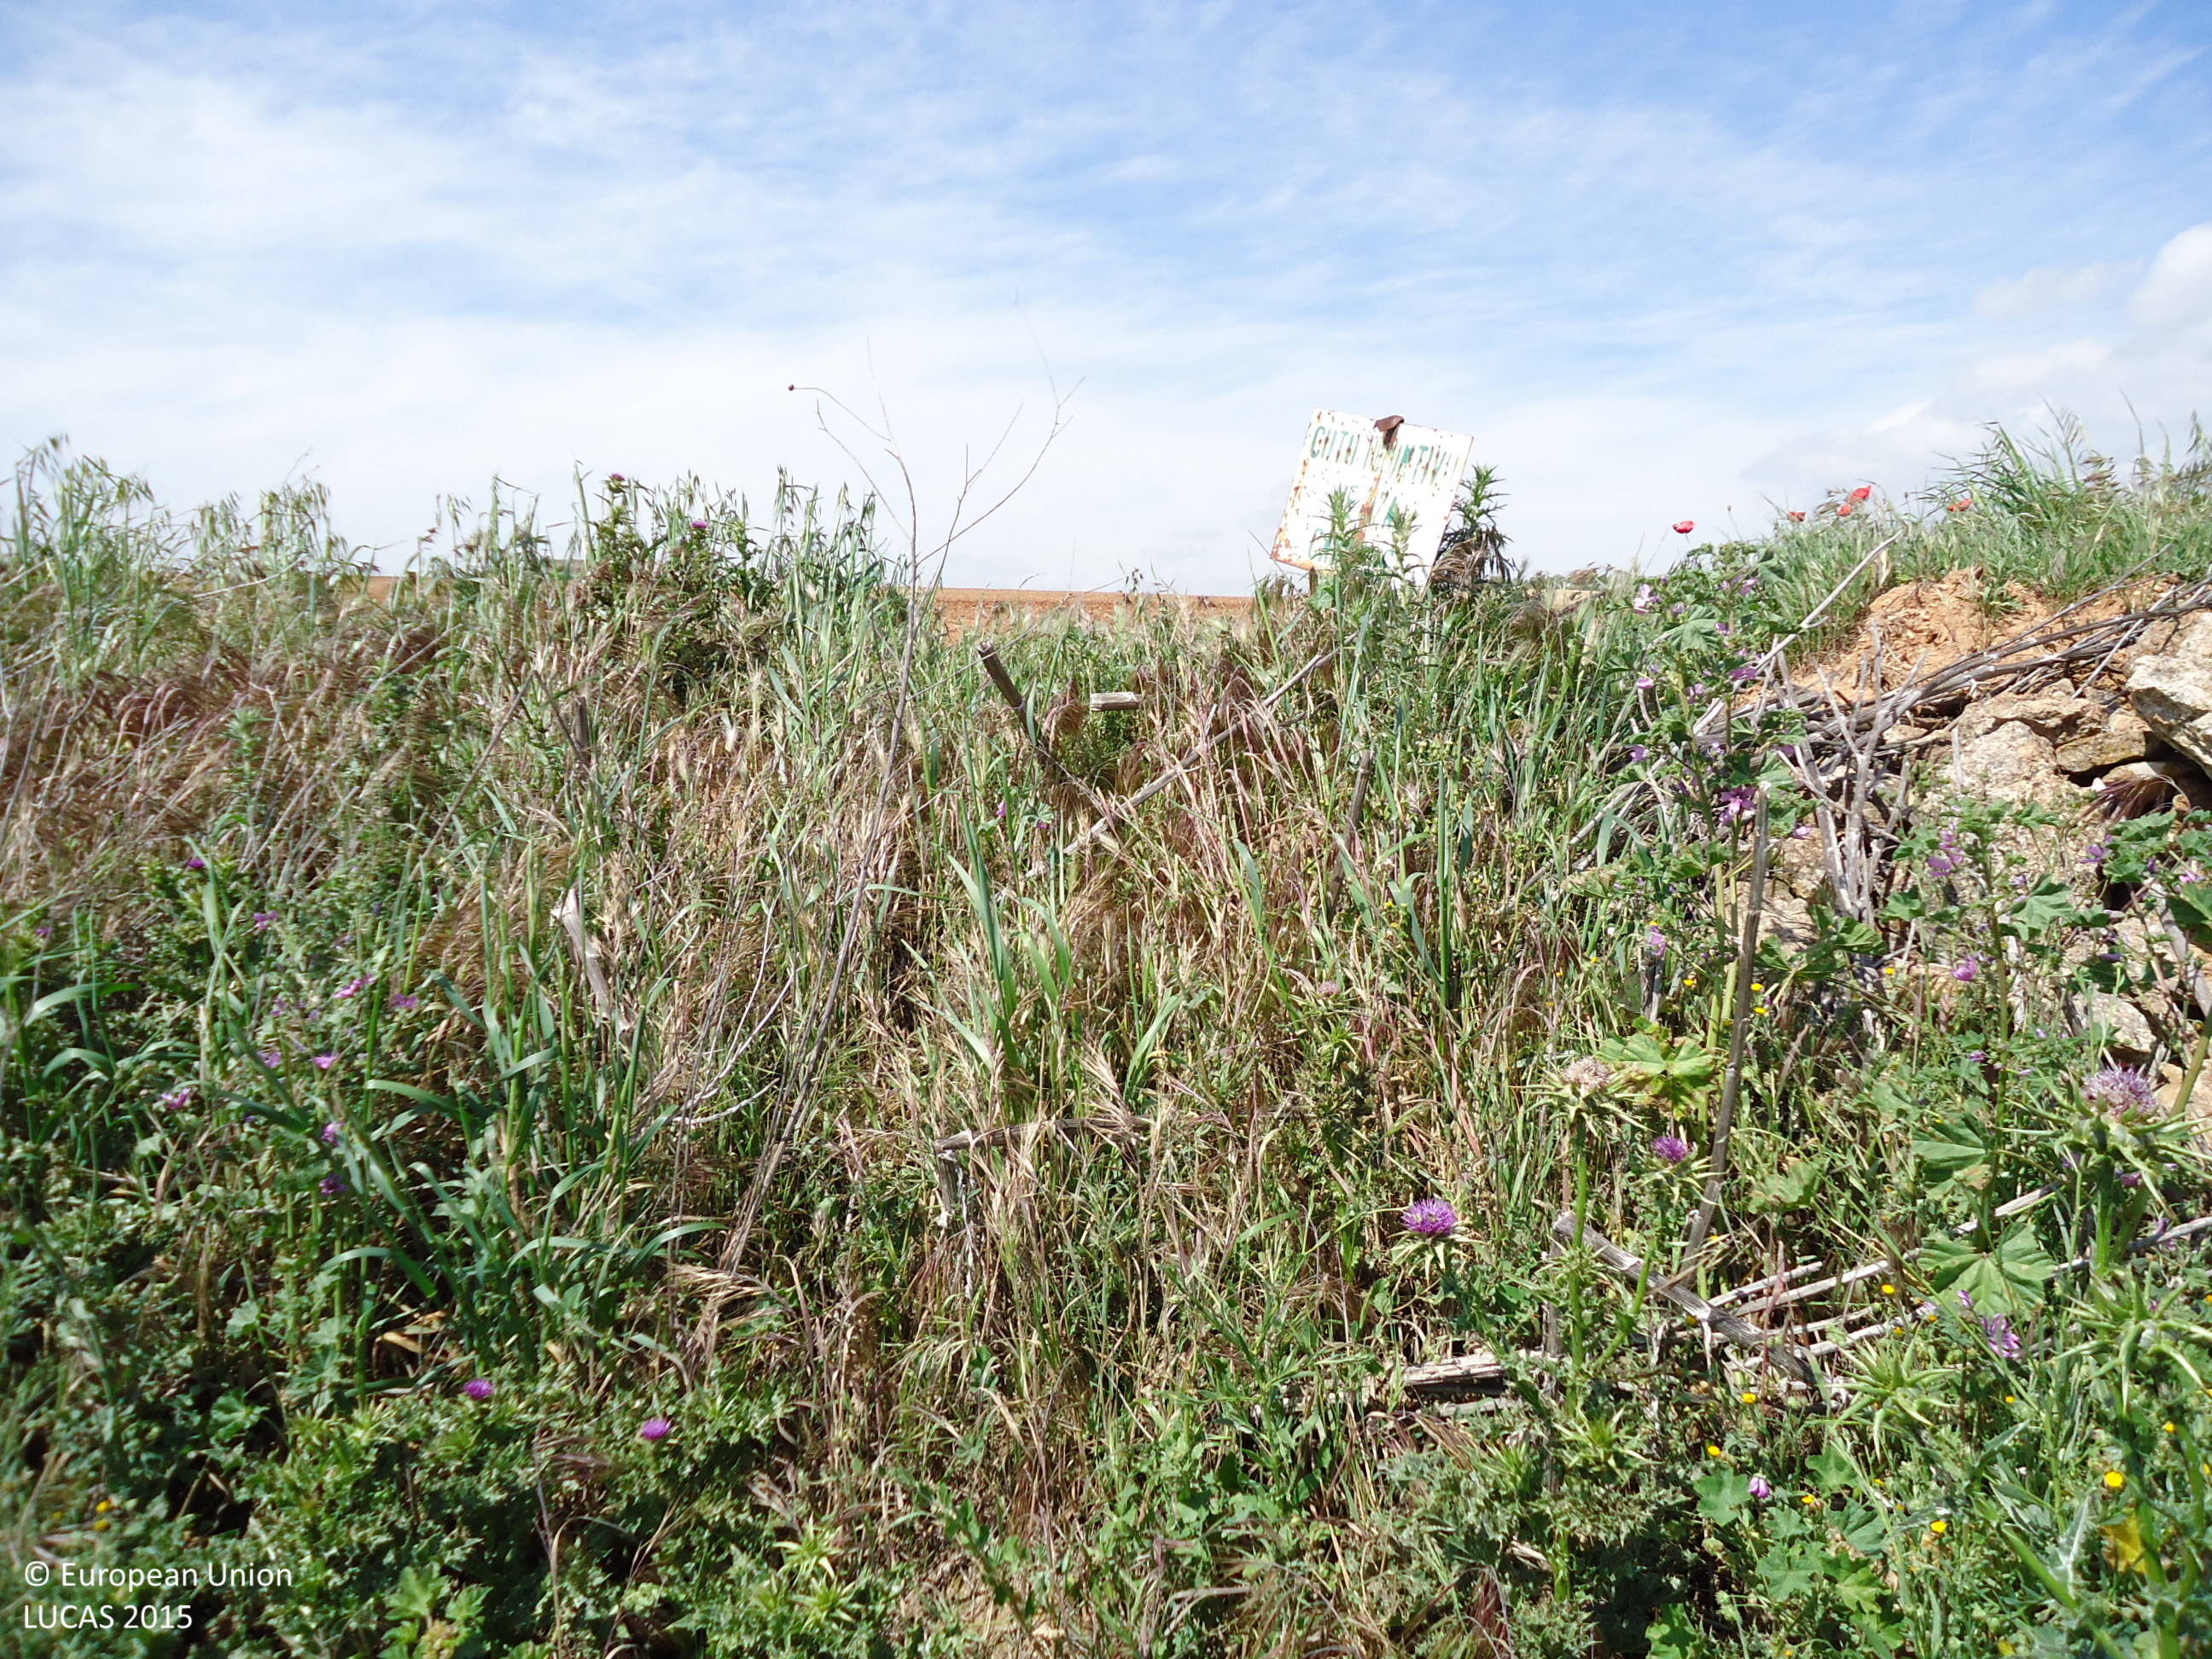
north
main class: Cropland
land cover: Oats
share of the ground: > 75 %
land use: Agriculture (excluding fallow land and kitchen gardens)
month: April
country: ES
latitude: 37.0414
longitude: -4.8073
